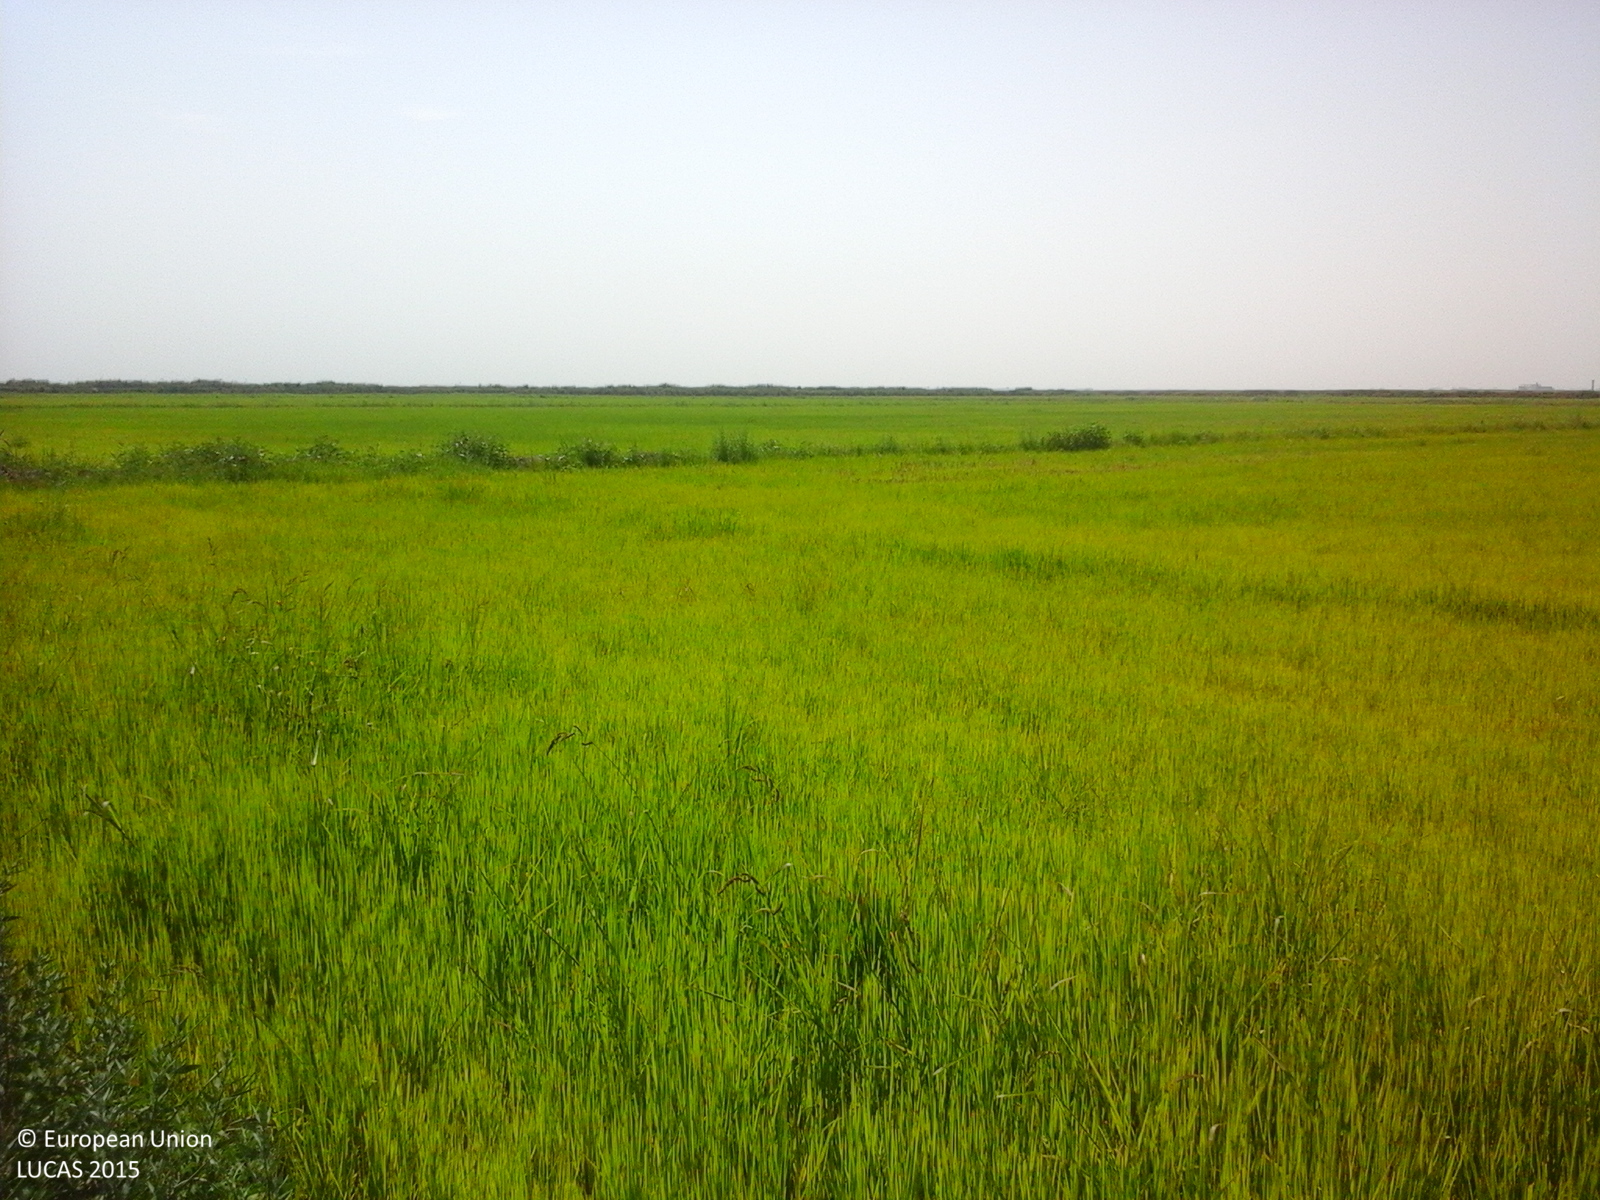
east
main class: Cropland
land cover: Rice
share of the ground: > 75 %
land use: Agriculture (excluding fallow land and kitchen gardens)
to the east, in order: Rice; Grass margins; Rice; Grass margins; Rice; Grass margins; Tracks; Grass margins; Rice
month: August
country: RO
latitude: 45.4035
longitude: 27.7525
